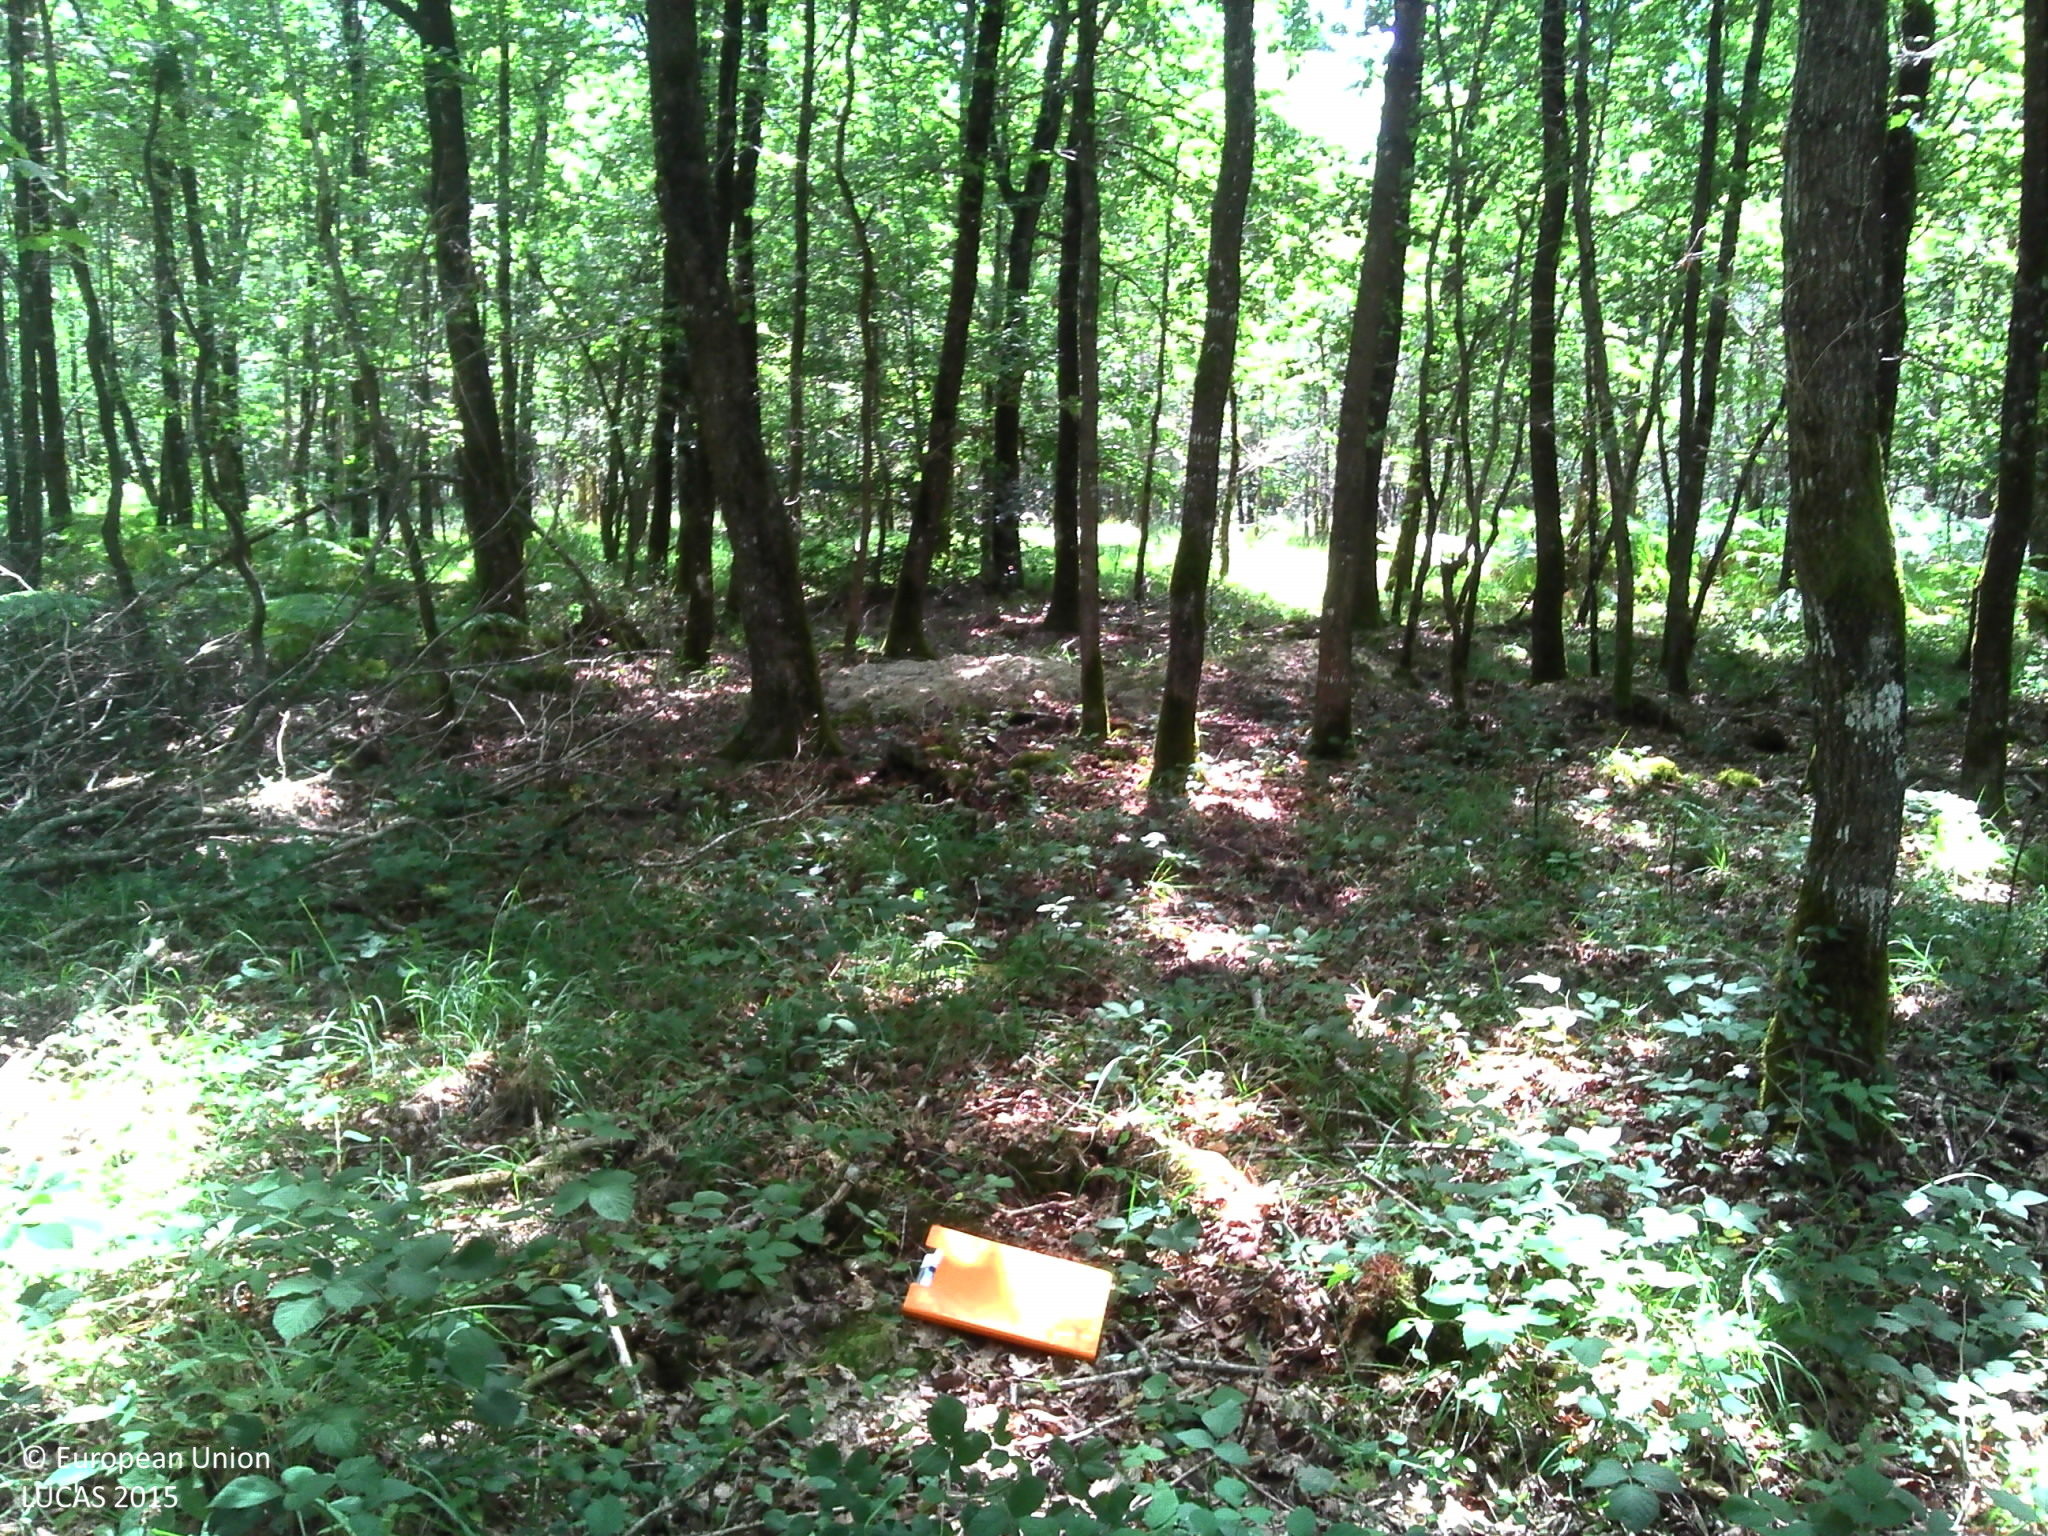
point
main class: Woodland
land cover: Broadleaved woodland
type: mesophytic deciduous forest
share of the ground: > 75 %
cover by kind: broadleaved forest trees 100 %
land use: Forestry
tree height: > 5 m
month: August
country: FR
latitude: 47.2387
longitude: 2.1575
